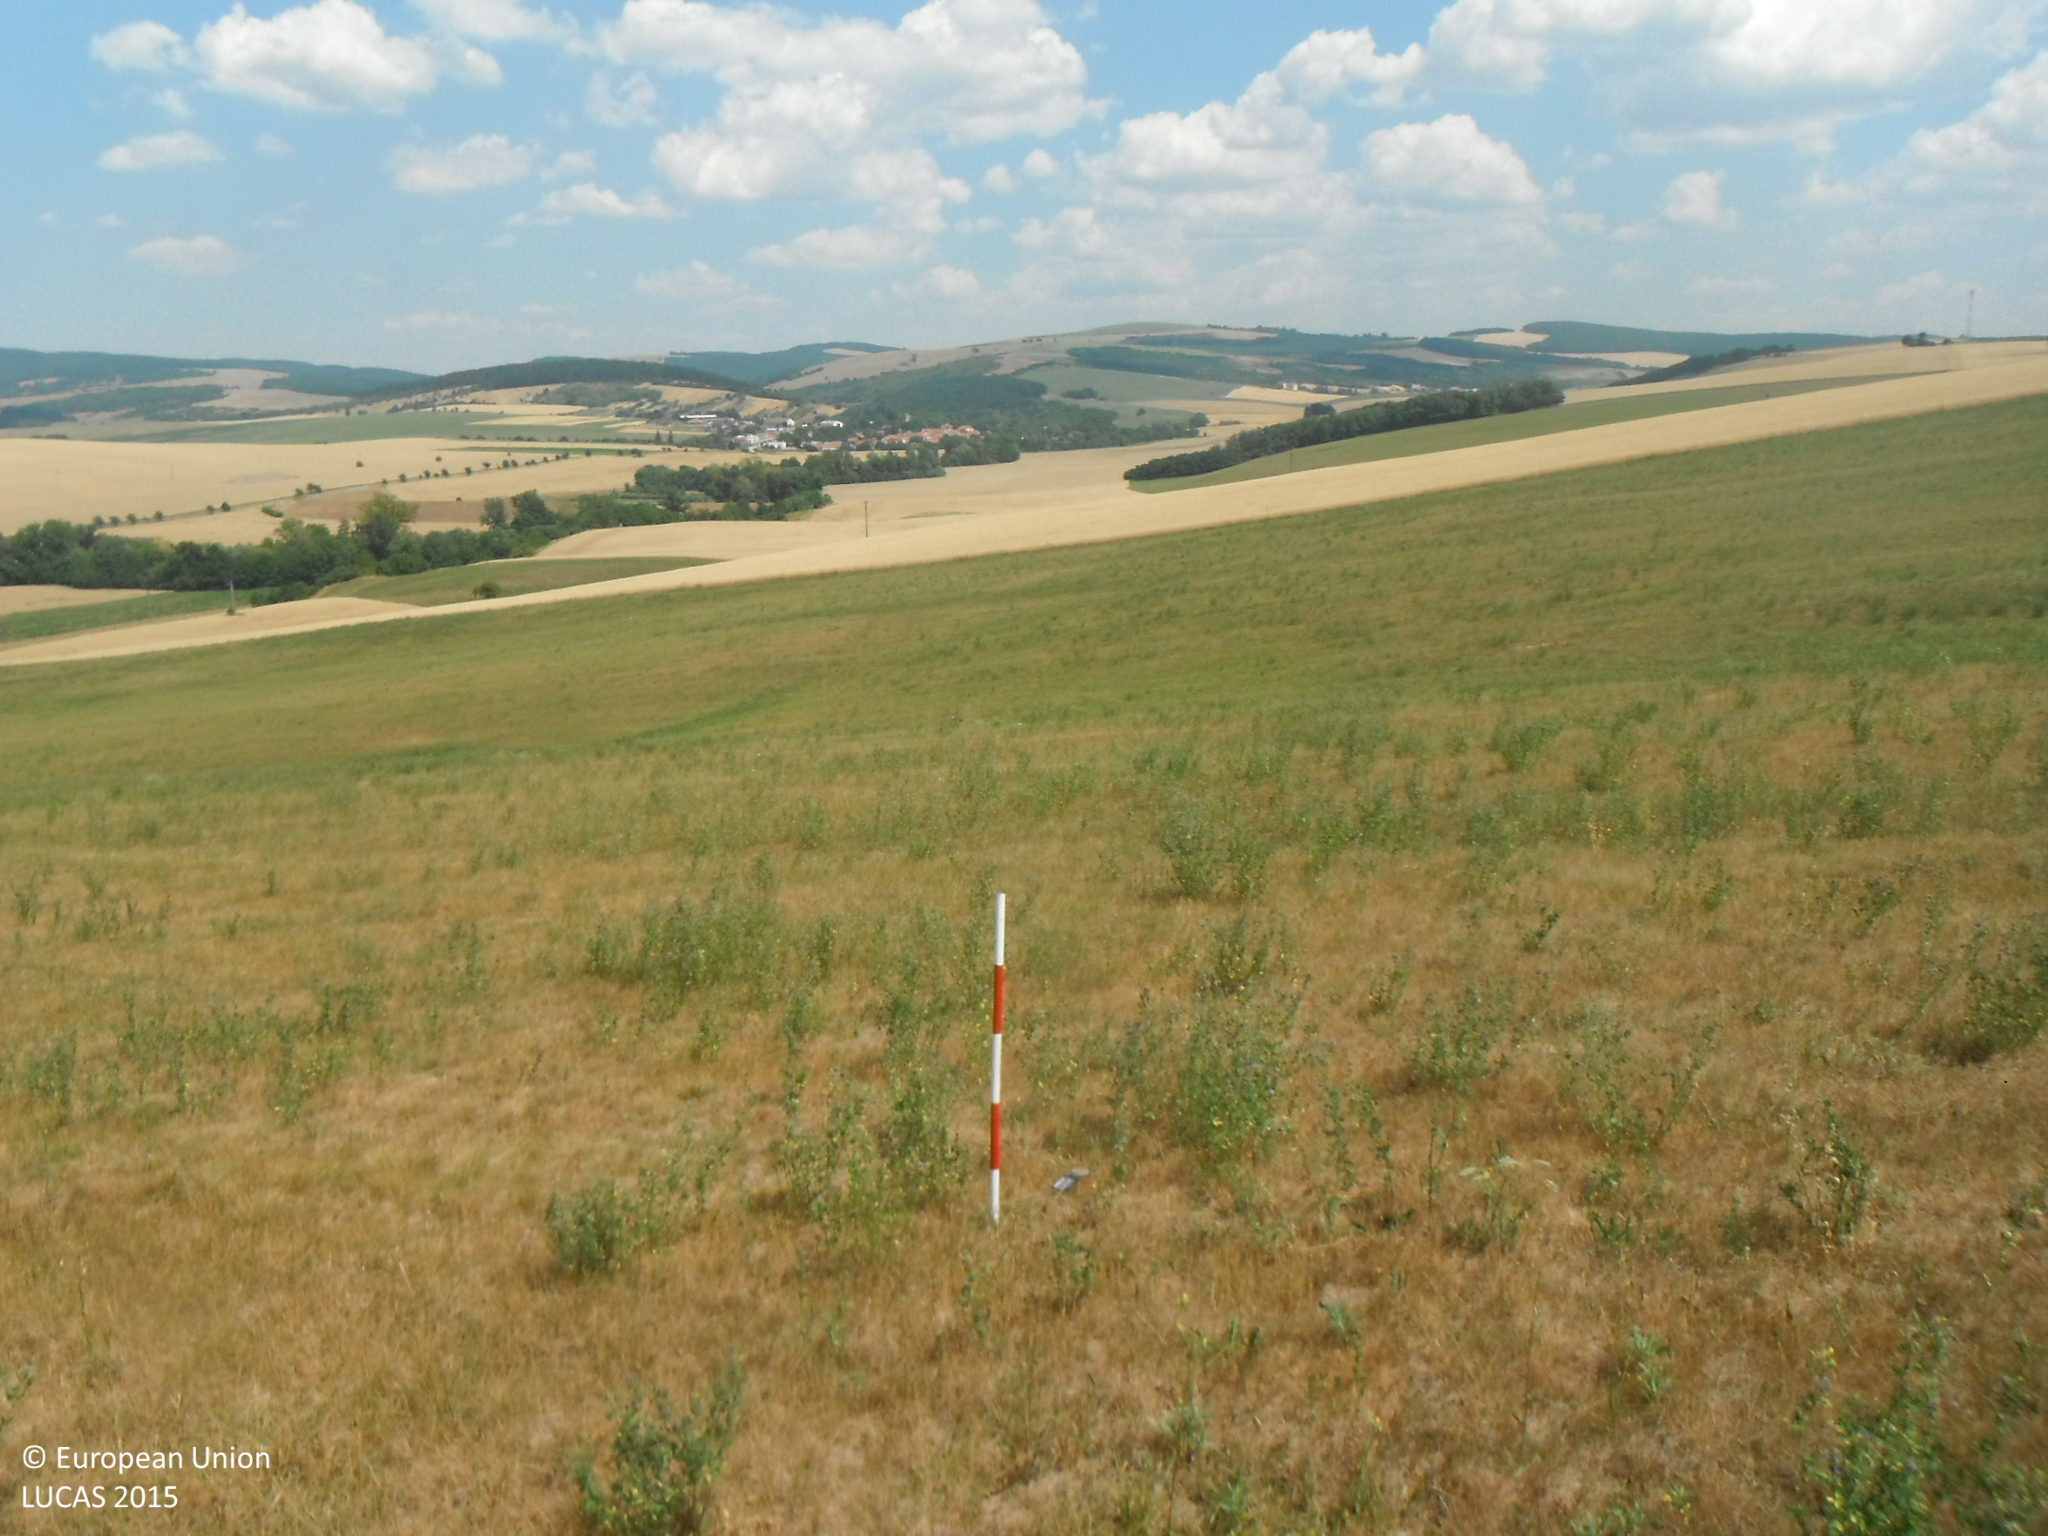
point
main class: Grassland
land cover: Grassland without tree/shrub cover
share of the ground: > 75 %
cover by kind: herbaceous plants 100 %
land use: Agriculture (excluding fallow land and kitchen gardens)
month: July
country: SK
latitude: 48.7393
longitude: 17.3121
